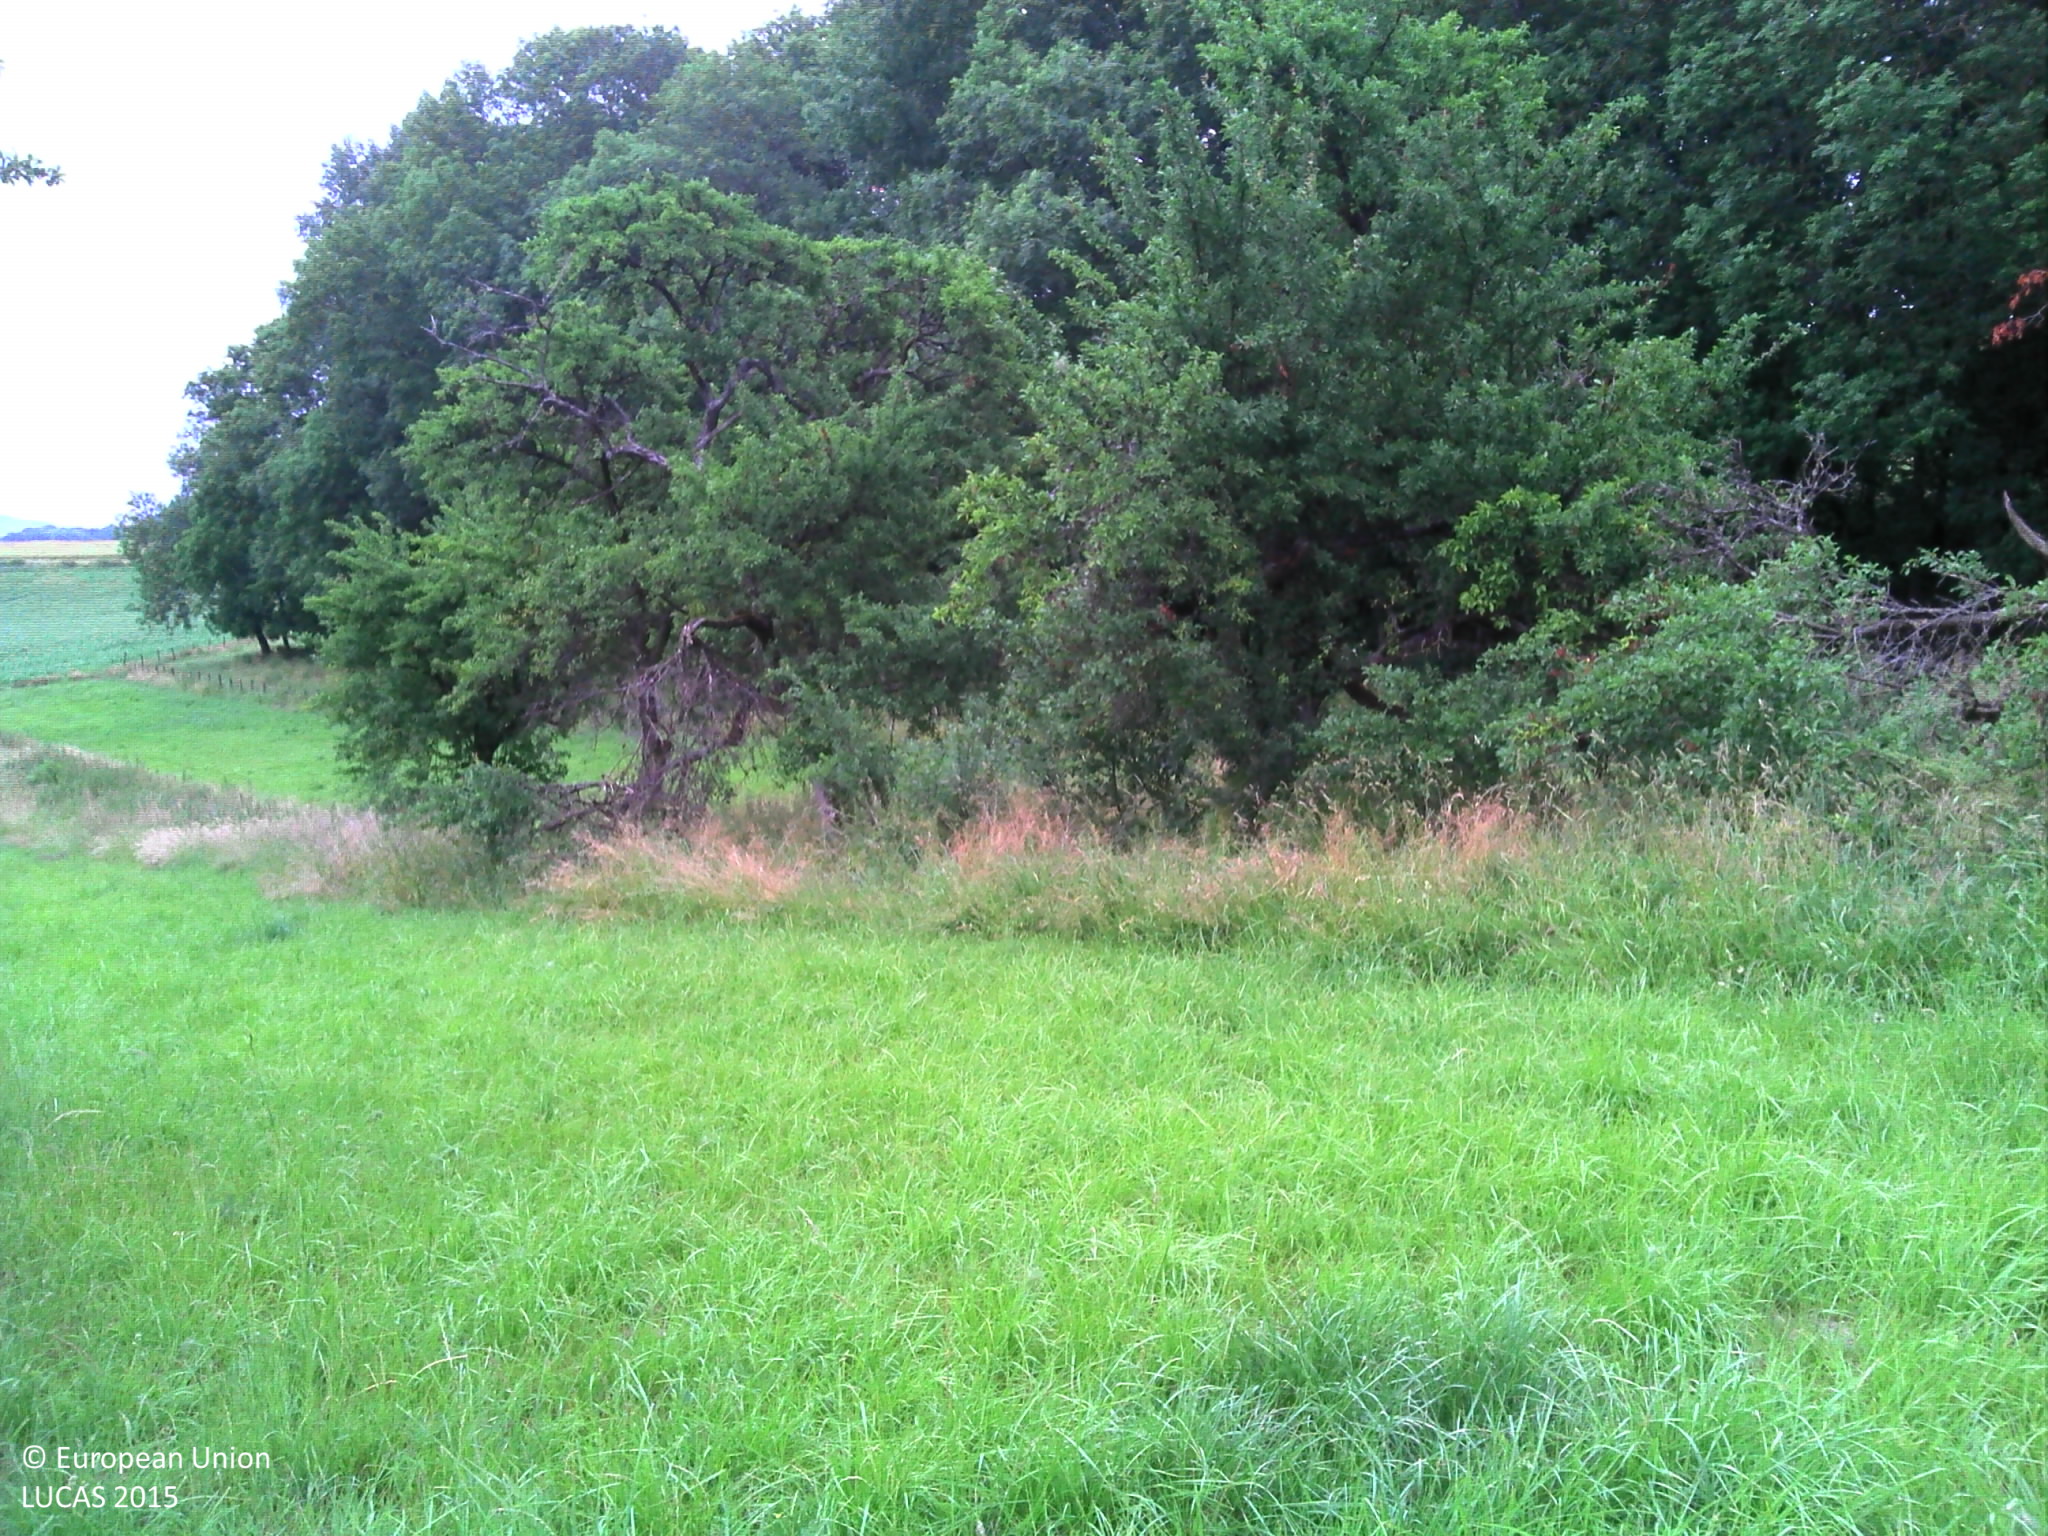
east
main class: Grassland
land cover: Grassland without tree/shrub cover
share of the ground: > 75 %
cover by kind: herbaceous plants 100 %
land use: Agriculture (excluding fallow land and kitchen gardens)
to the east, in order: Grassland without tree/shrub cover; Other fruit trees and berries; Grassland without tree/shrub cover; Other fruit trees and berries; Grassland without tree/shrub cover; Fences; Grassland without tree/shrub cover; Broadleaved woodland; Grassland without tree/shrub cover; Single bushes/trees; Grassland without tree/shrub cover; Lines of trees; Grassland without tree/shrub cover
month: June
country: FR
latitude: 48.5578
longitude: 6.3013
